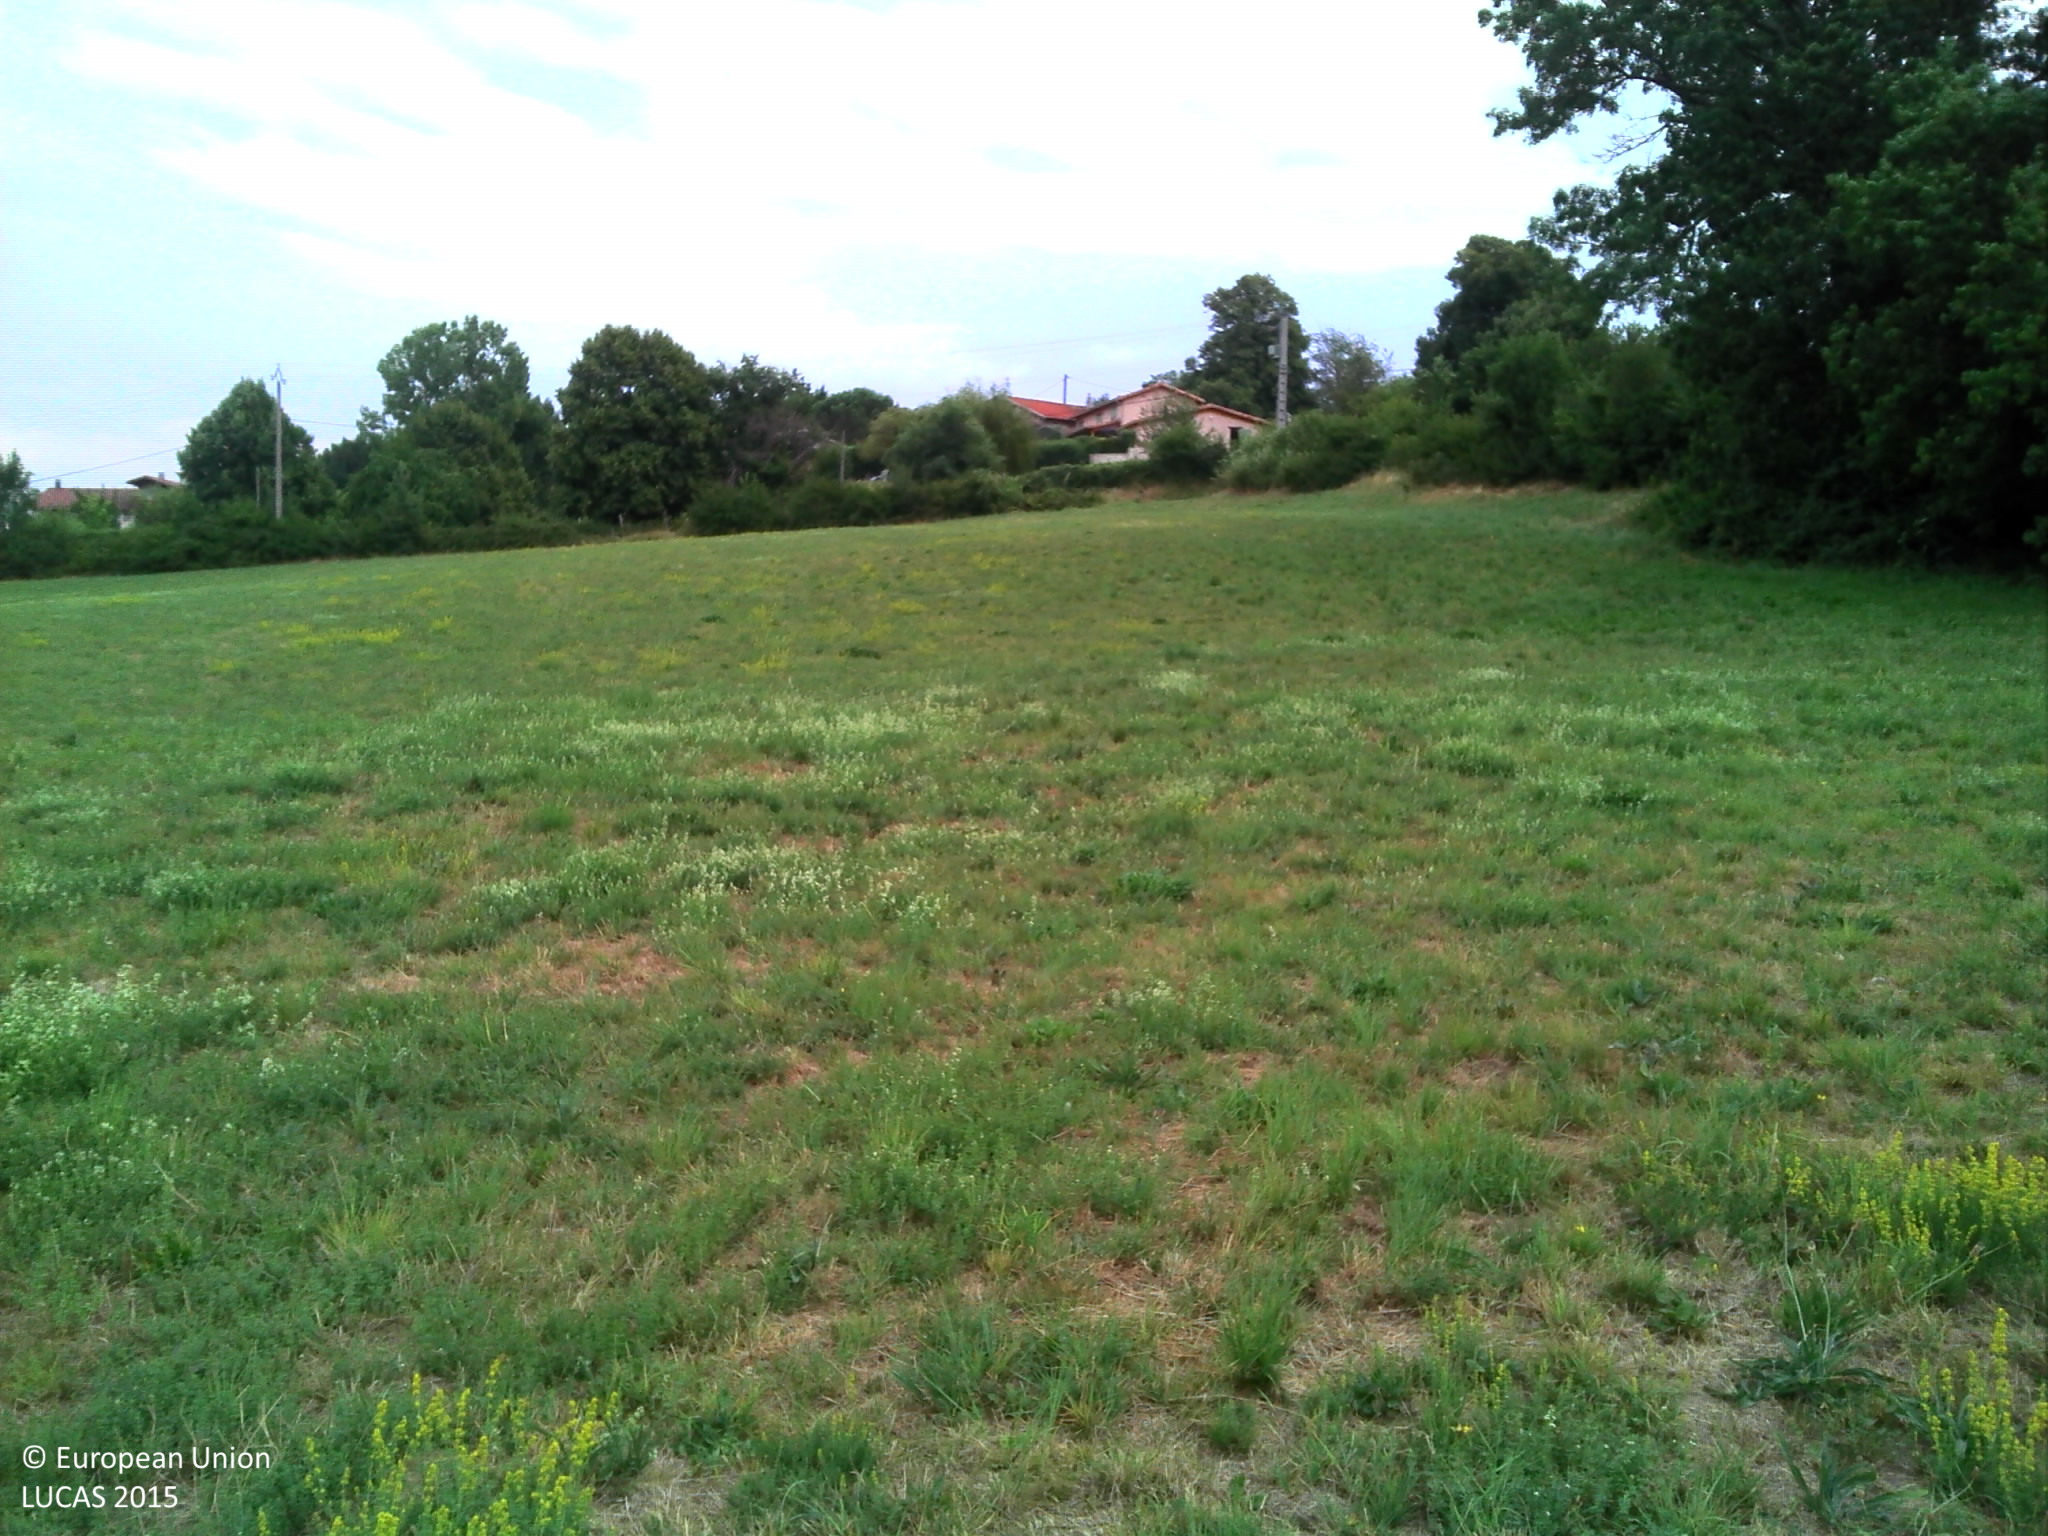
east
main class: Grassland
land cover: Grassland without tree/shrub cover
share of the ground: > 75 %
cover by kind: herbaceous plants 100 %
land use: Agriculture (excluding fallow land and kitchen gardens)
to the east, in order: Grassland without tree/shrub cover; Artificial constructions in urban areas; Grassland without tree/shrub cover; Fences; Grassland without tree/shrub cover; Fences; Grassland without tree/shrub cover; Managed hedges; Fences; Electric lines; Paved roads, cycling and walking lanes; Grass margins; Managed hedges; Fences; Grassland with sparse tree/shrub cover; Artificial constructions in urban areas
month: July
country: FR
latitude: 45.4751
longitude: 4.9771
